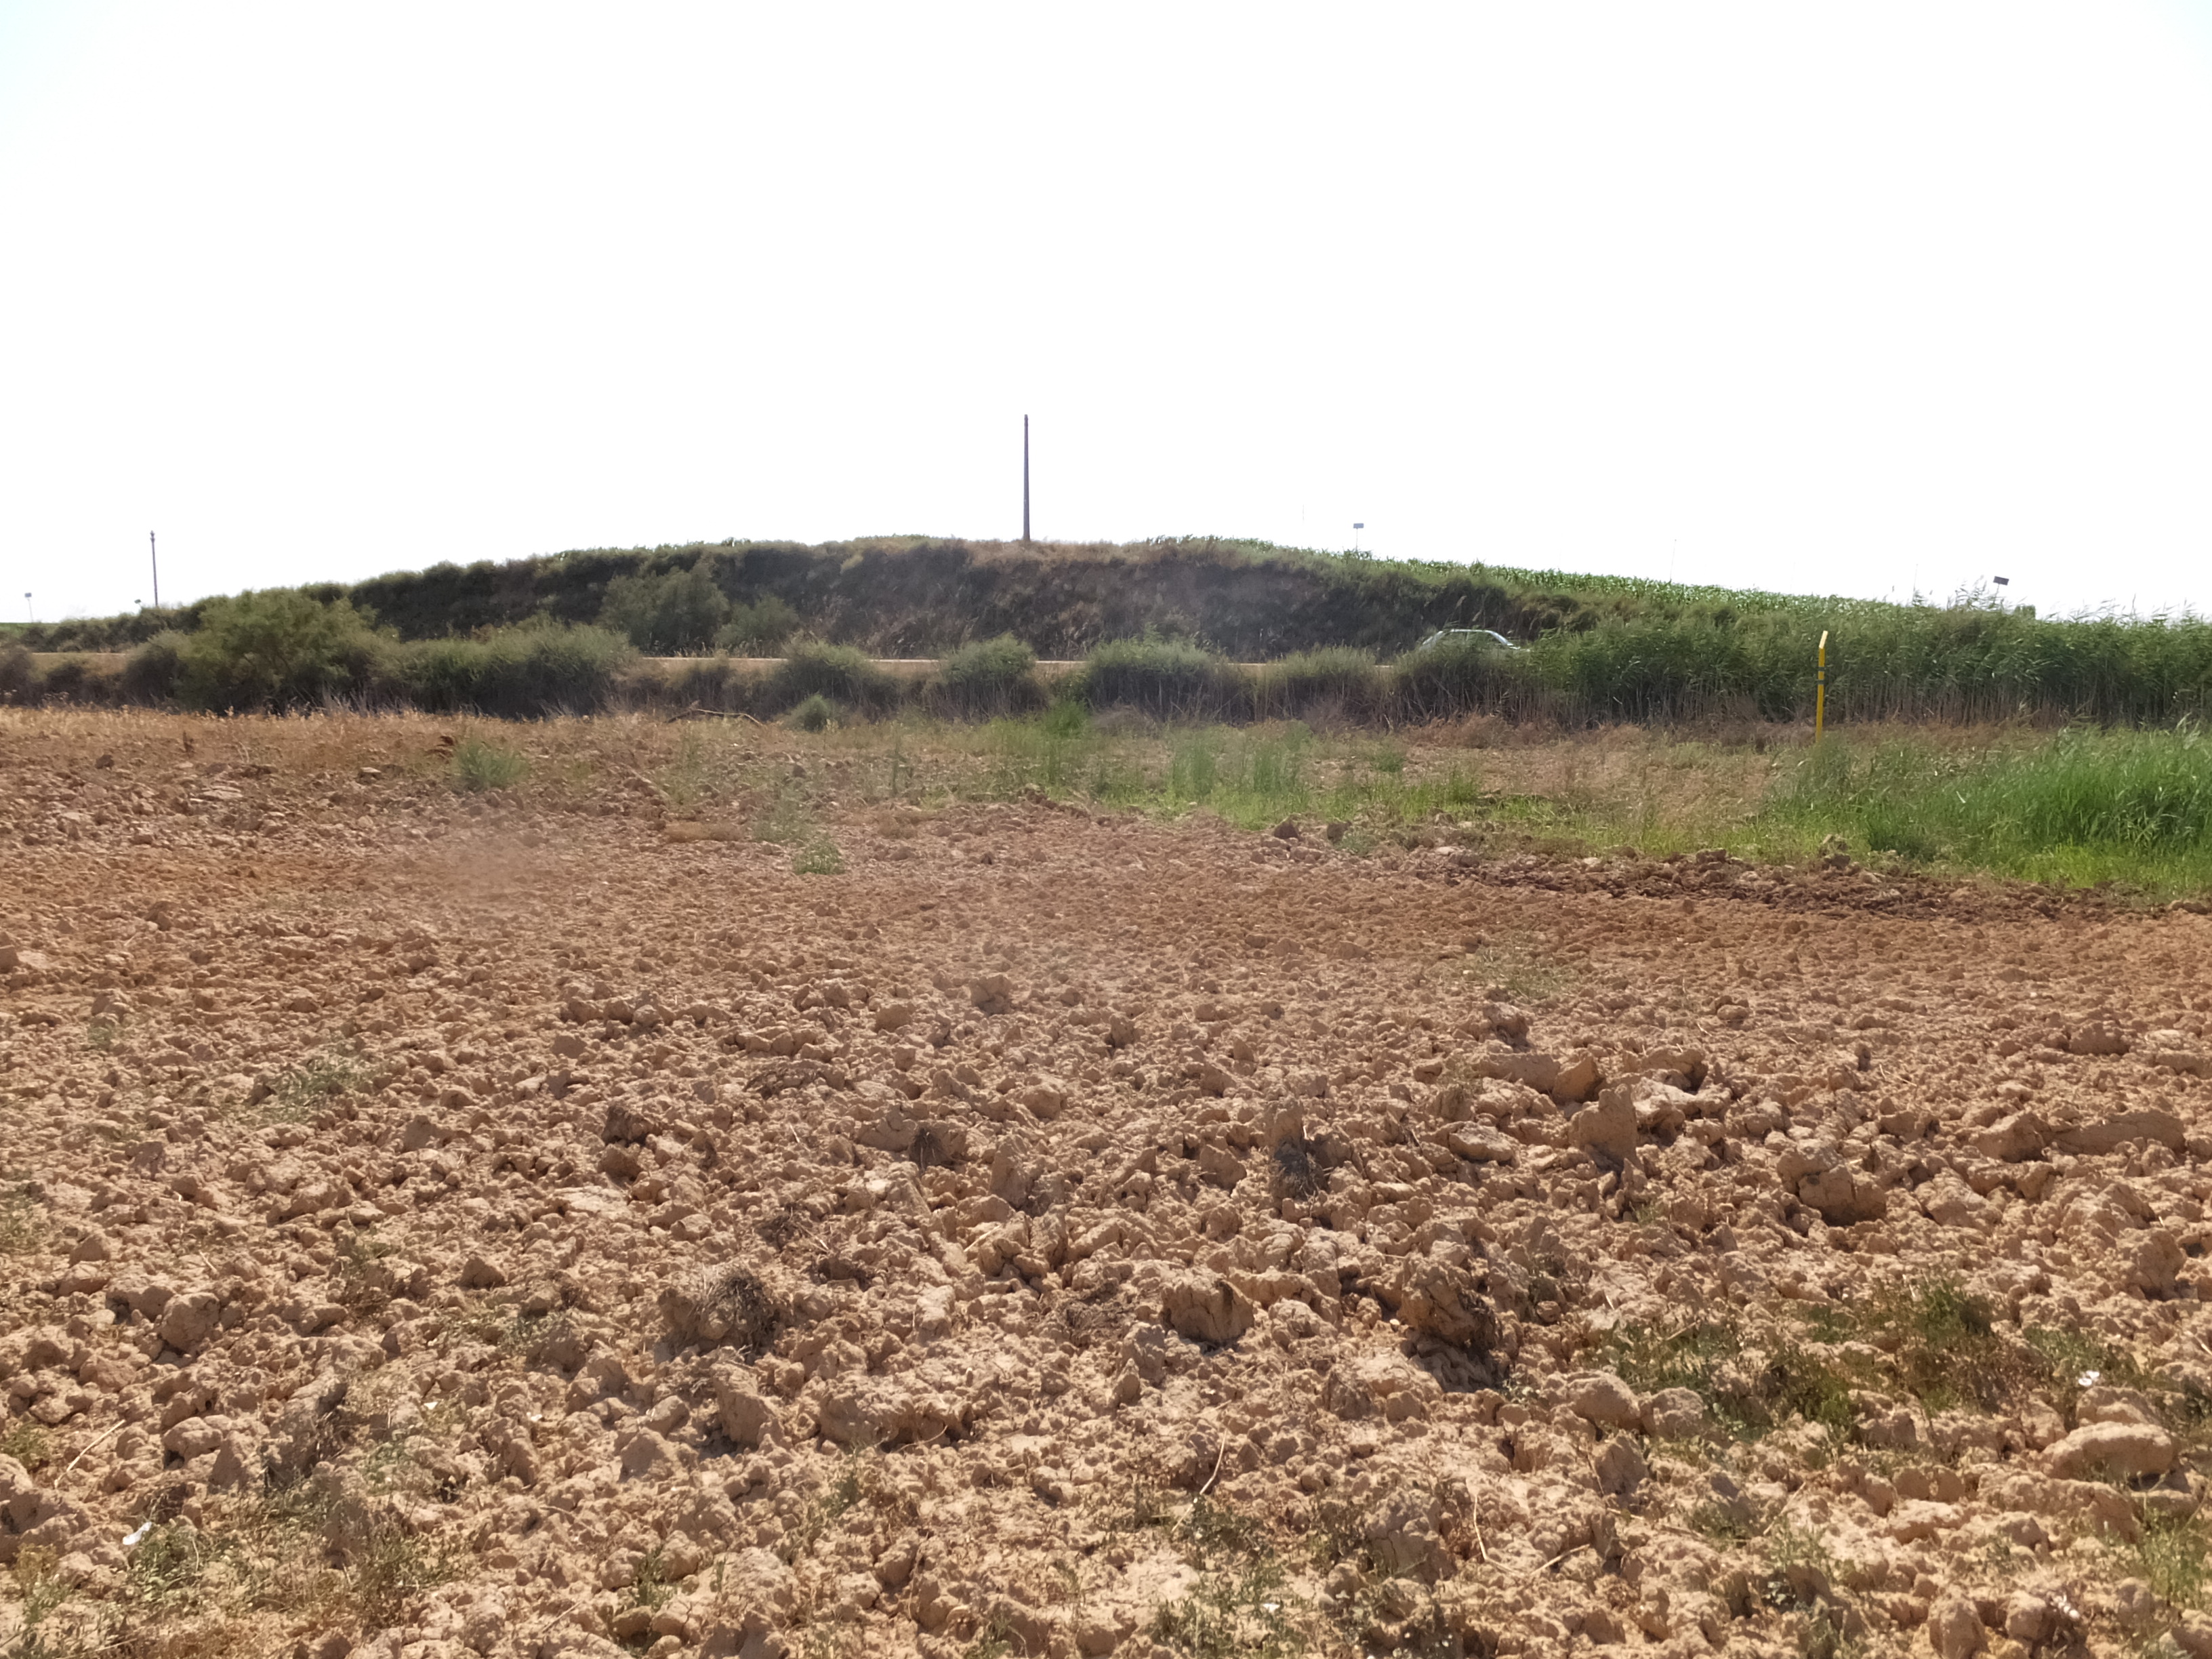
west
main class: Cropland
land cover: Maize
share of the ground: > 75 %
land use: Agriculture (excluding fallow land and kitchen gardens)
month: July
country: ES
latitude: 41.6798
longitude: 0.3154
